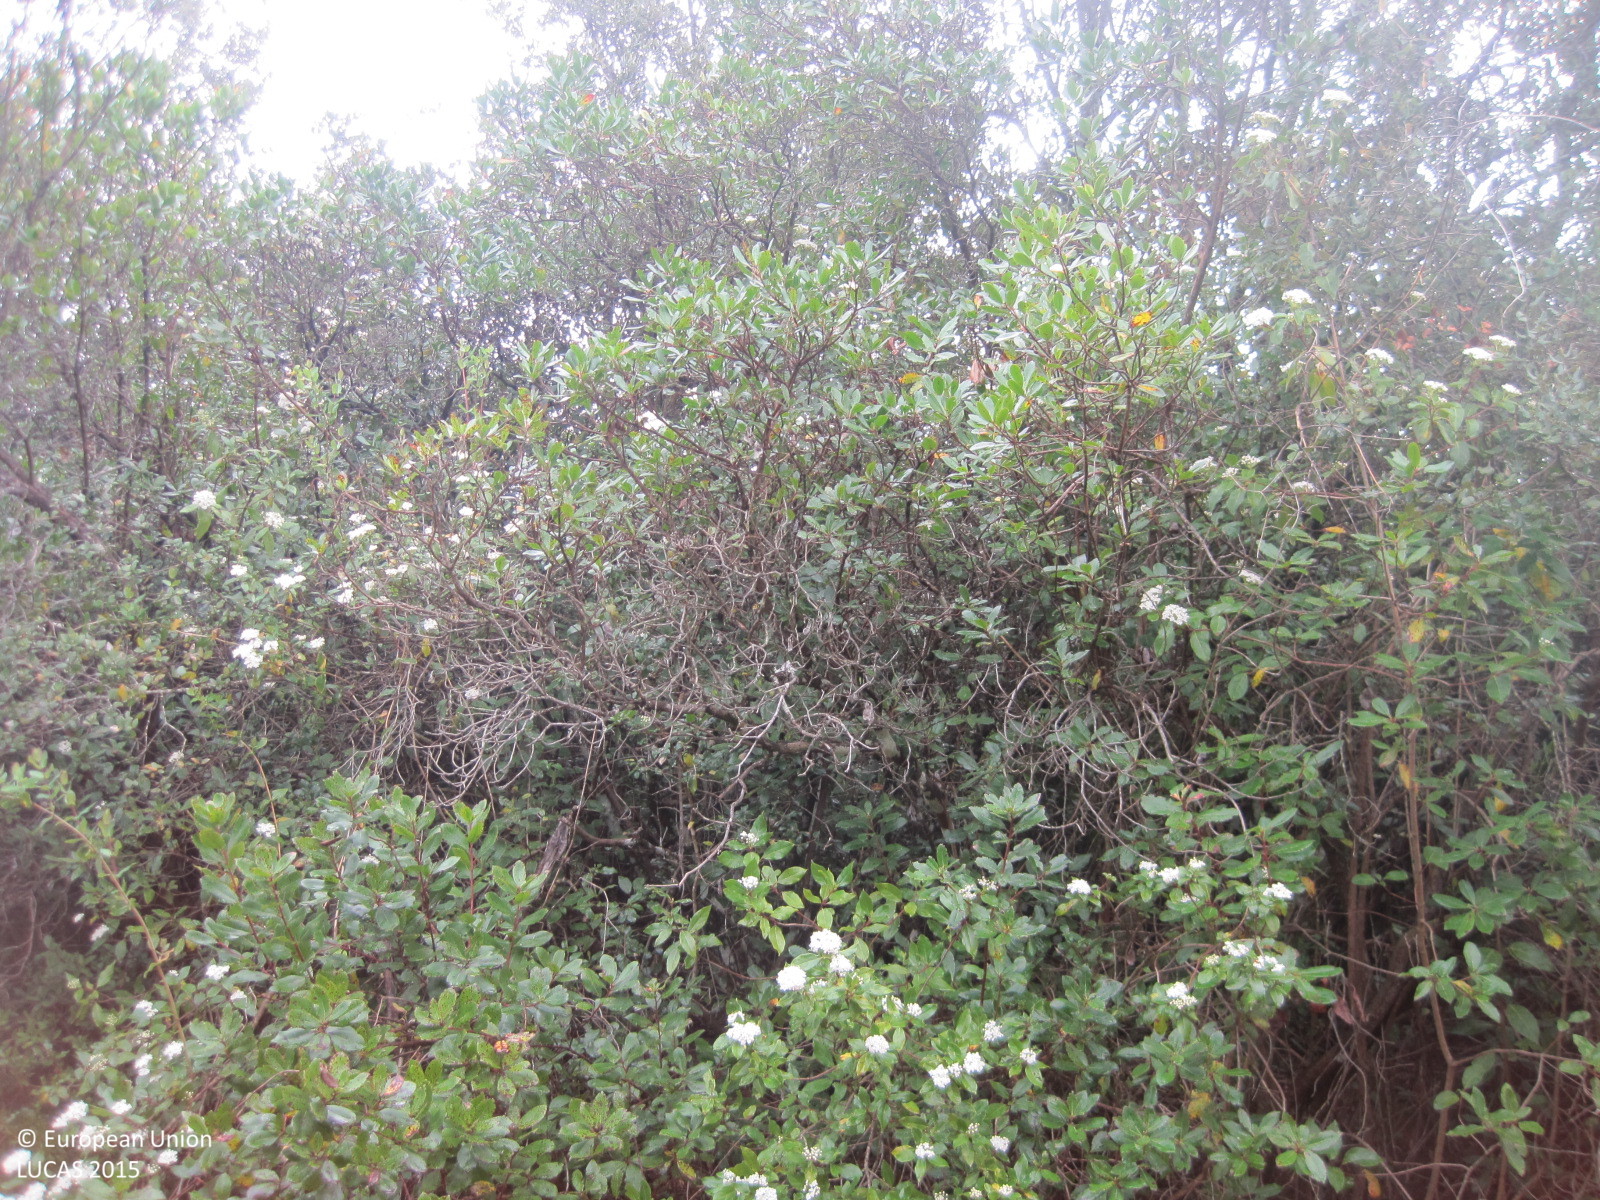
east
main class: Woodland
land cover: Broadleaved woodland
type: broadleaved evergreen forest
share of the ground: > 75 %
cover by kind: broadleaved forest trees 100 %
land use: Forestry
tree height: > 5 m
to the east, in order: Broadleaved woodland; Tracks; Broadleaved woodland; Tracks; Fences; Broadleaved woodland; Fences; Tracks; Broadleaved woodland
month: April
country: ES
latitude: 42.6784
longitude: -2.2107
